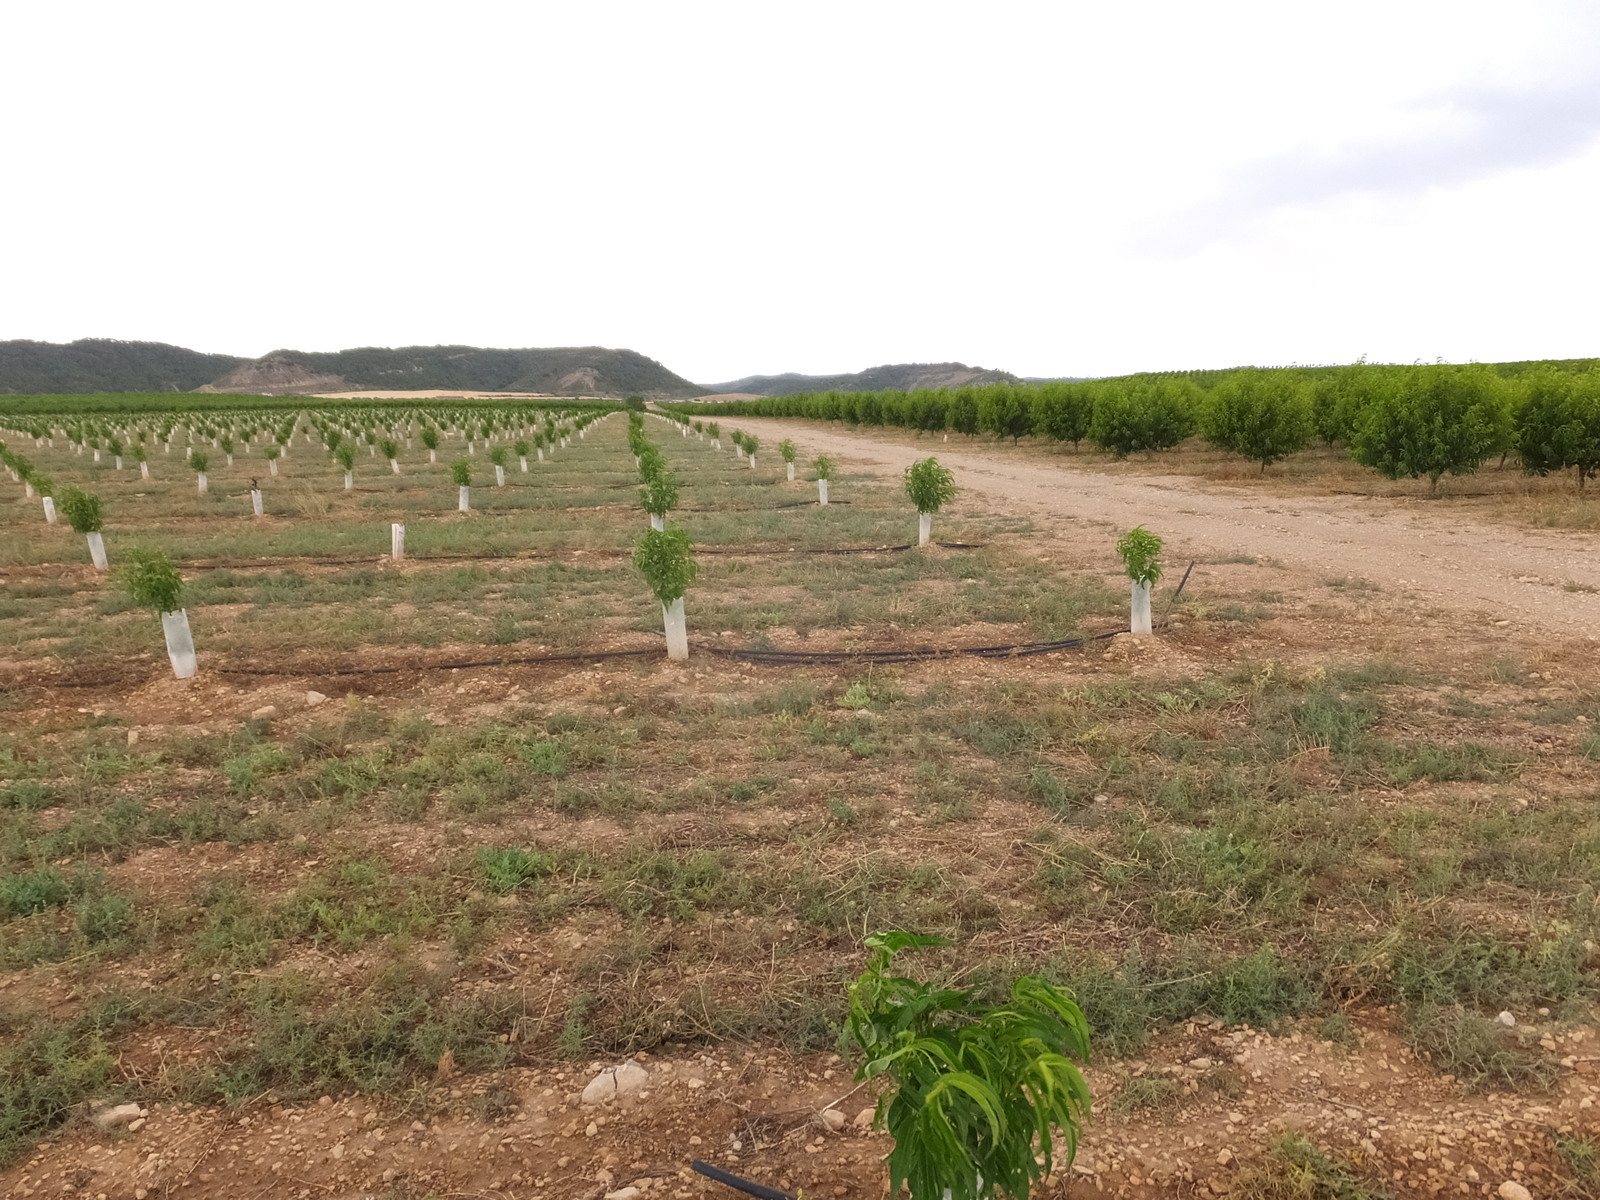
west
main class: Cropland
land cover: Other fruit trees and berries
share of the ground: < 10 %
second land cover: Spontaneously vegetated surfaces
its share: 50 - 75 %
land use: Agriculture (excluding fallow land and kitchen gardens)
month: June
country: ES
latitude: 41.6338
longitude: 0.0330
